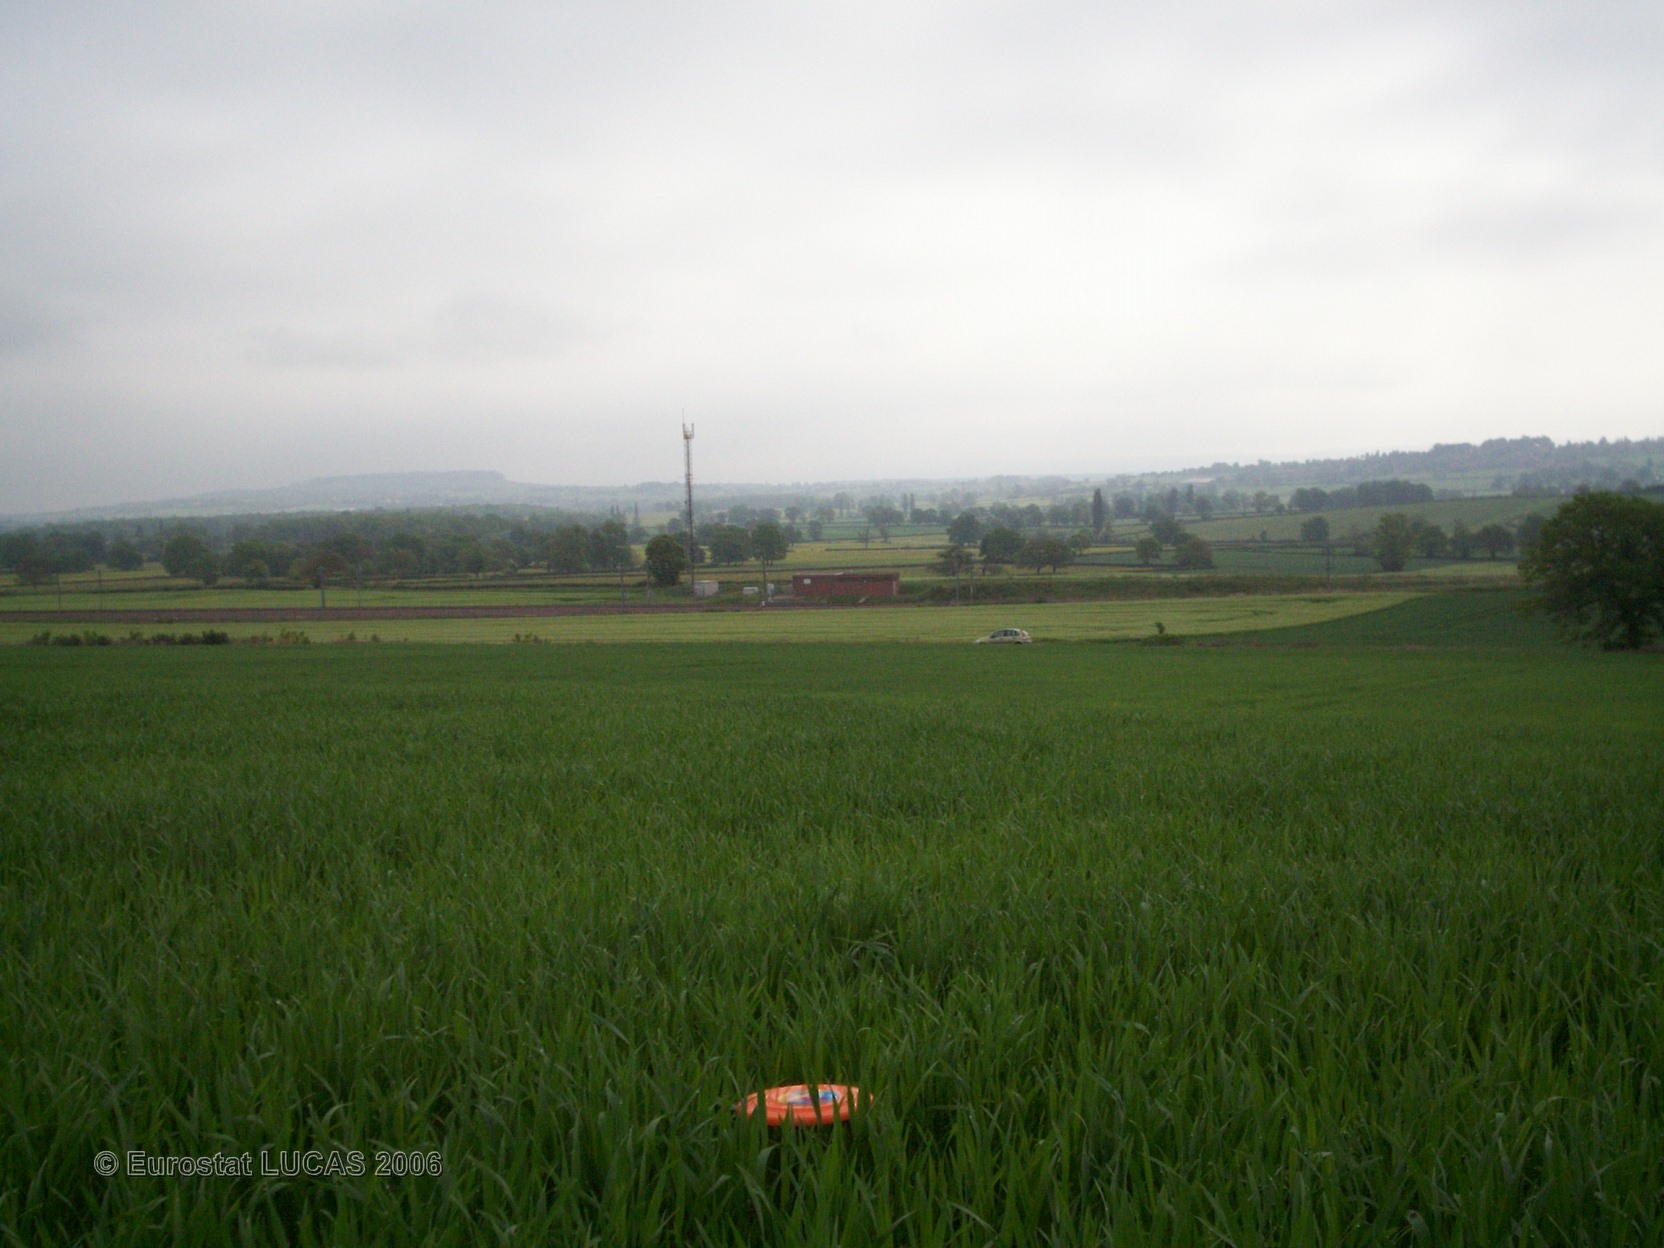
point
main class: Cropland
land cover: Common wheat
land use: Agriculture (excluding fallow land and kitchen gardens)
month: May
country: FR
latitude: 46.5239
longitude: 4.6437
